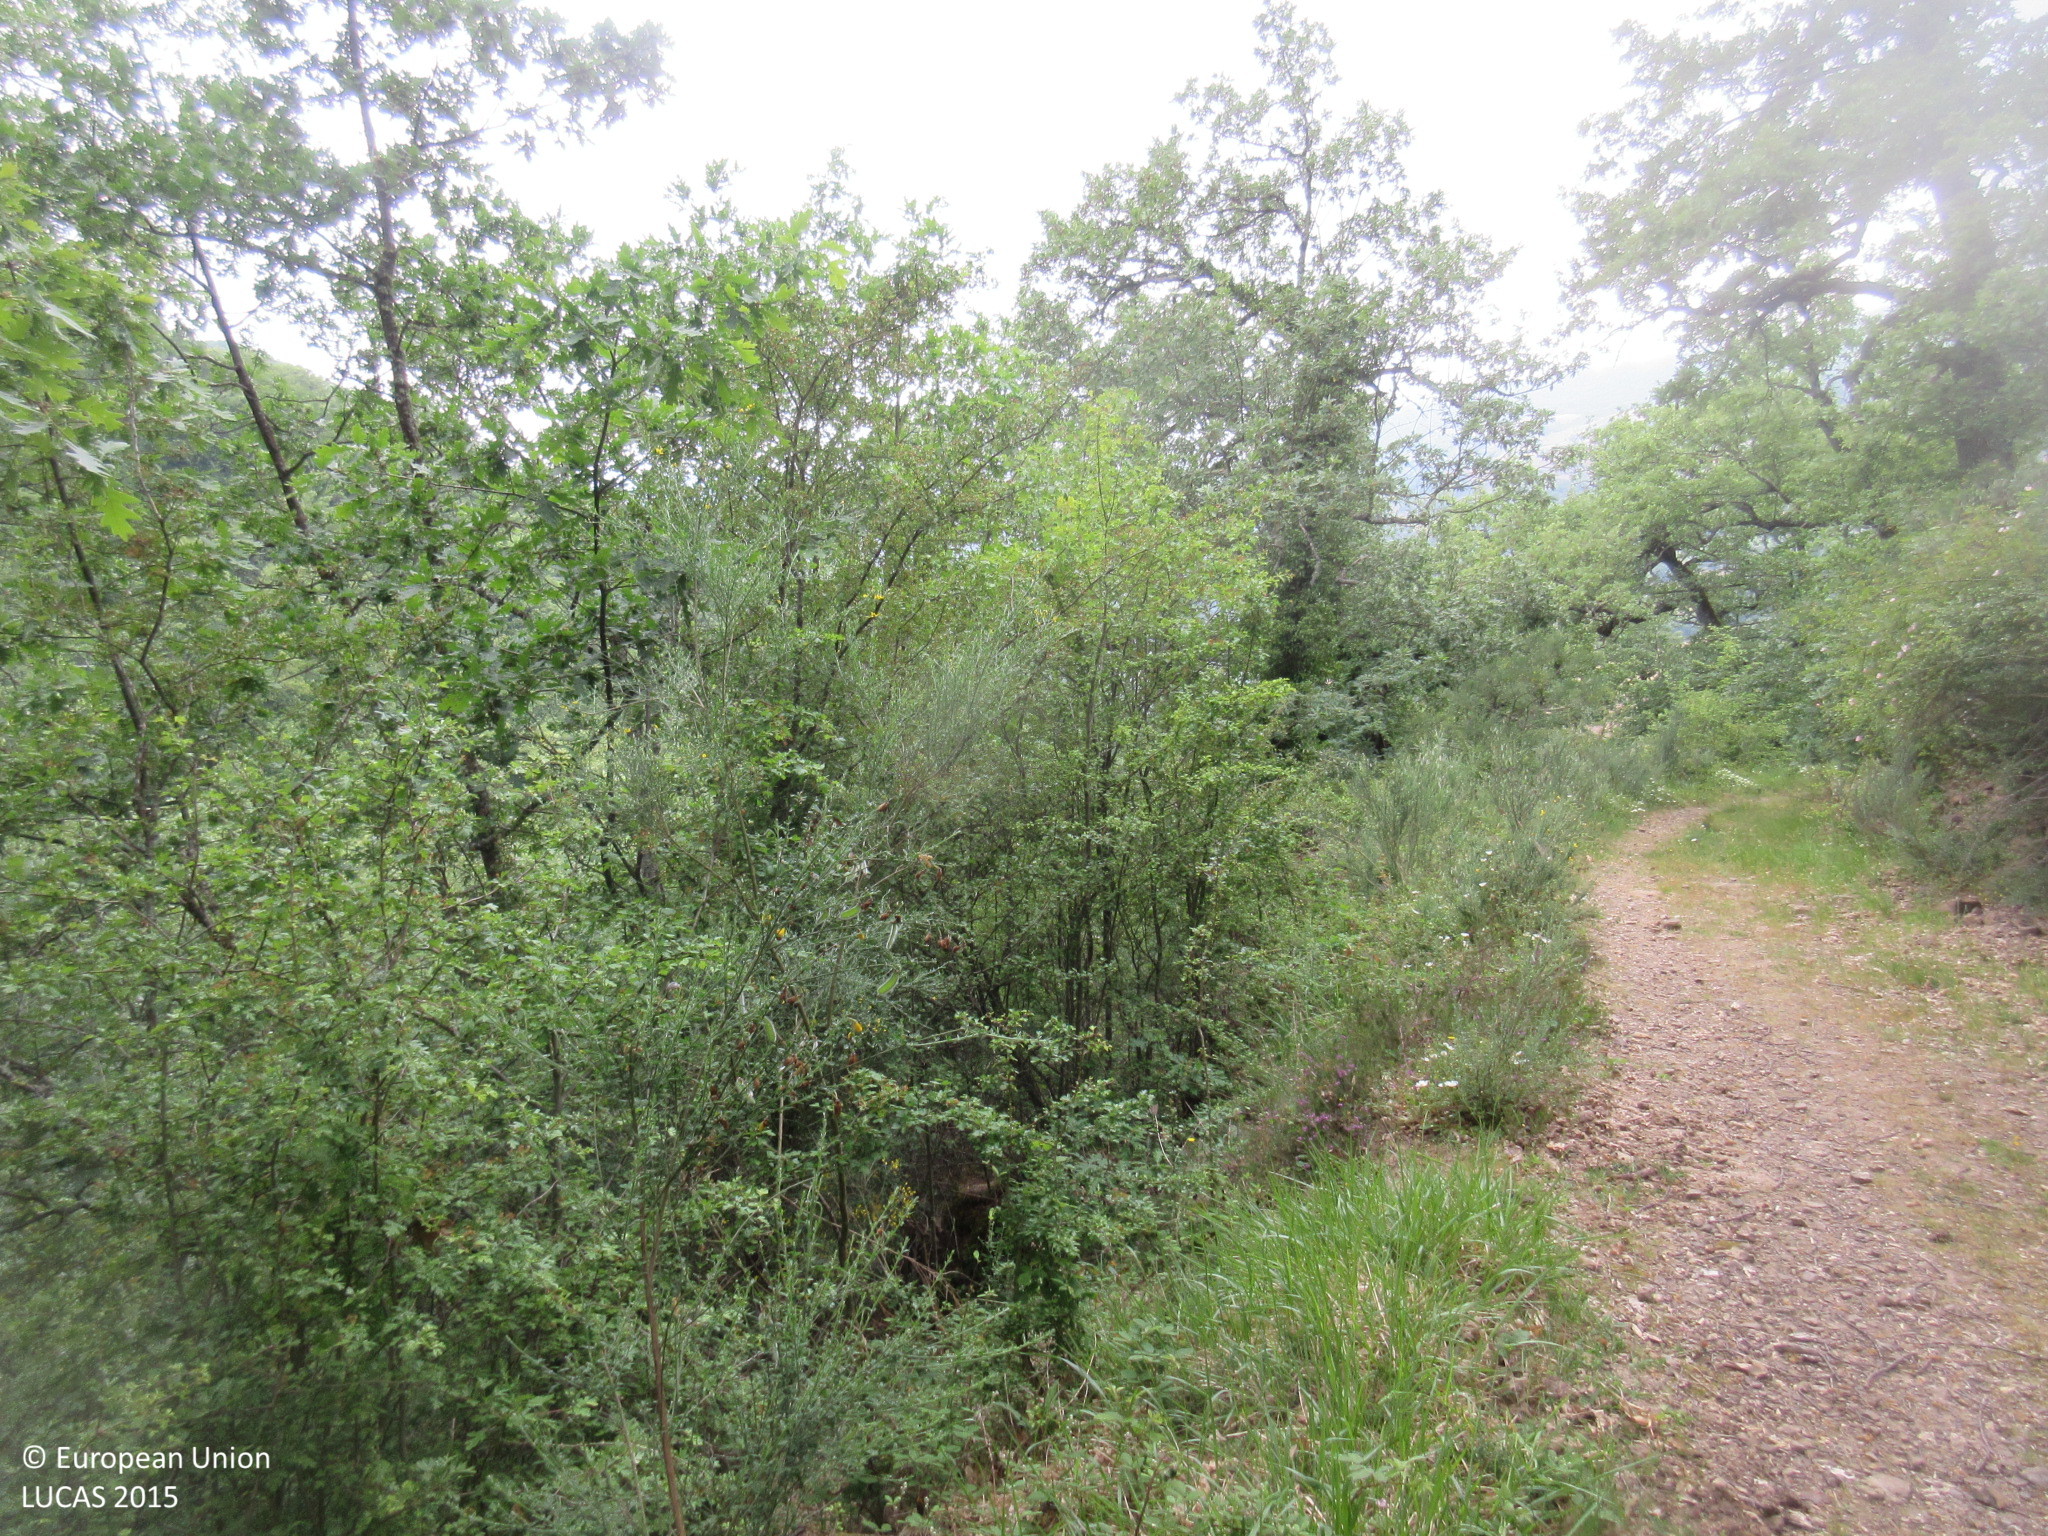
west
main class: Woodland
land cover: Broadleaved woodland
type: thermophilous deciduous forest
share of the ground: > 75 %
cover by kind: broadleaved forest trees 95 %, unconsolidated bare surface 5 %
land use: Semi-natural and natural areas not in use
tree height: > 5 m
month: June
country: ES
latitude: 43.1385
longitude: -4.5289
